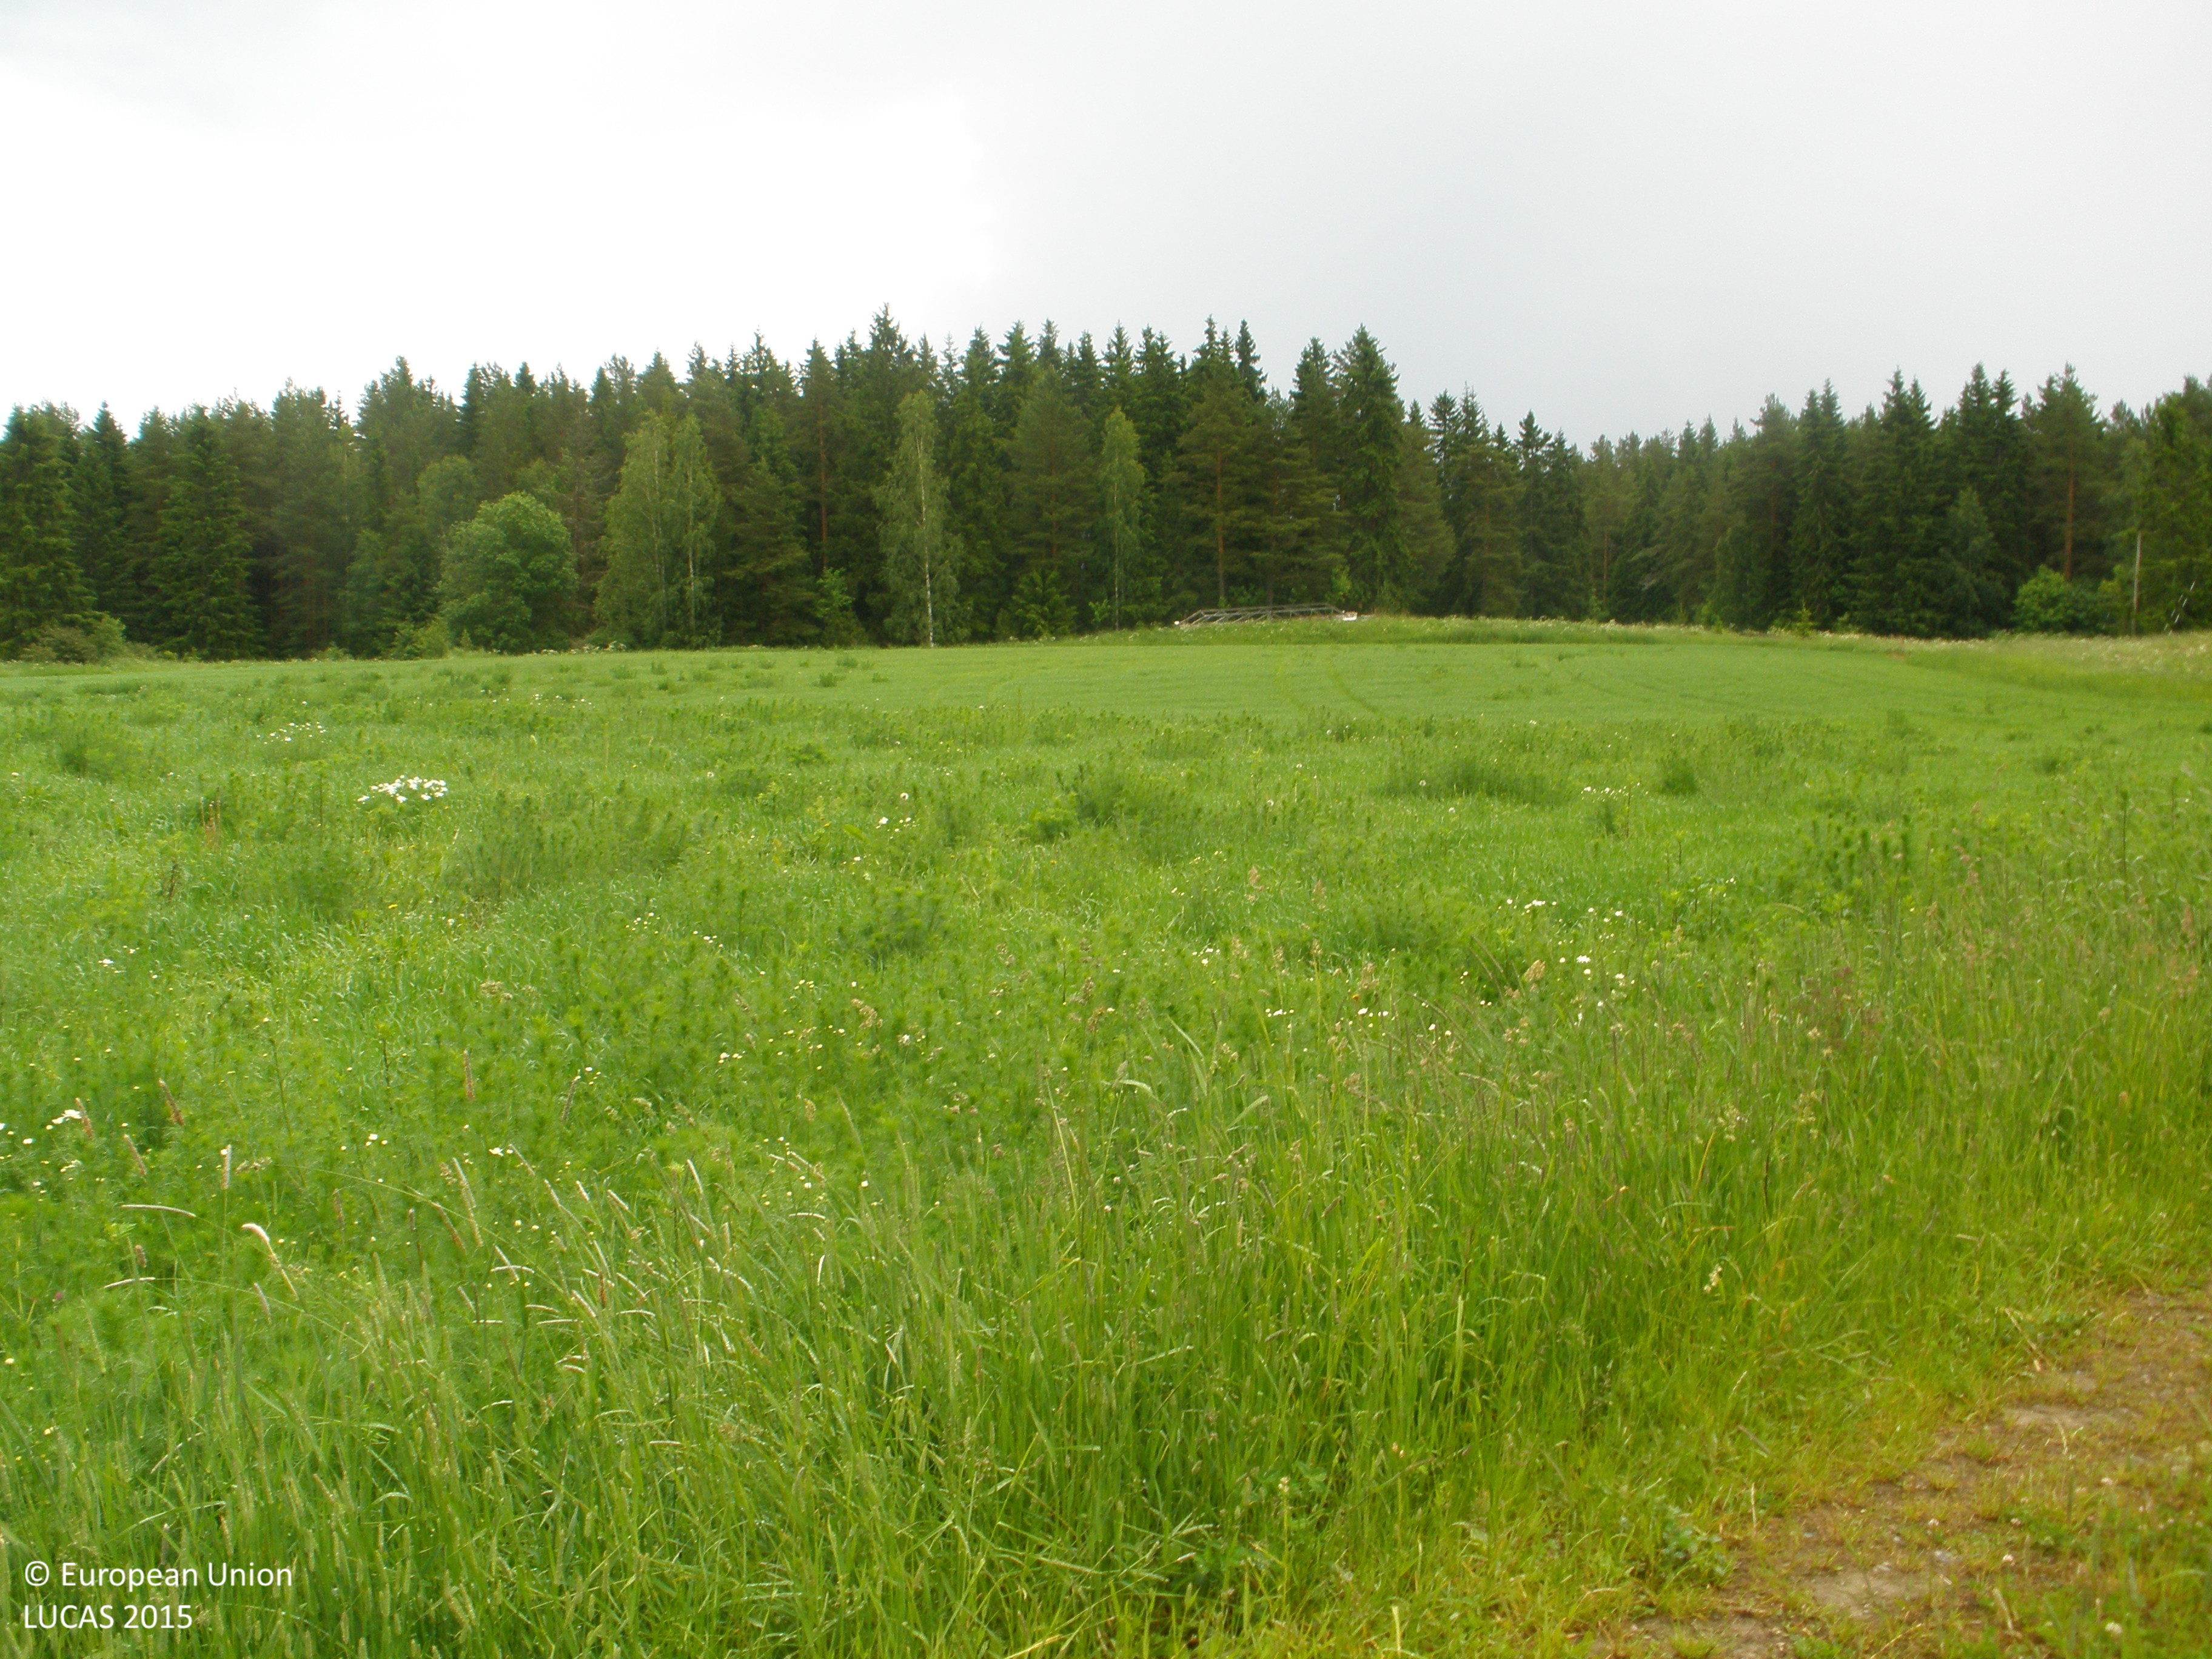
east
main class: Cropland
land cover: Barley
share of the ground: > 75 %
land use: Agriculture (excluding fallow land and kitchen gardens)
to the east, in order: Barley; Ditches and canals; Grass margins; Tracks; Grass margins; Ditches and canals; Barley; Grass margins; Ditches and canals; Spontaneously vegetated surfaces; Spruce dominated mixed woodland
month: June
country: FI
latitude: 61.1422
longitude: 23.8518
